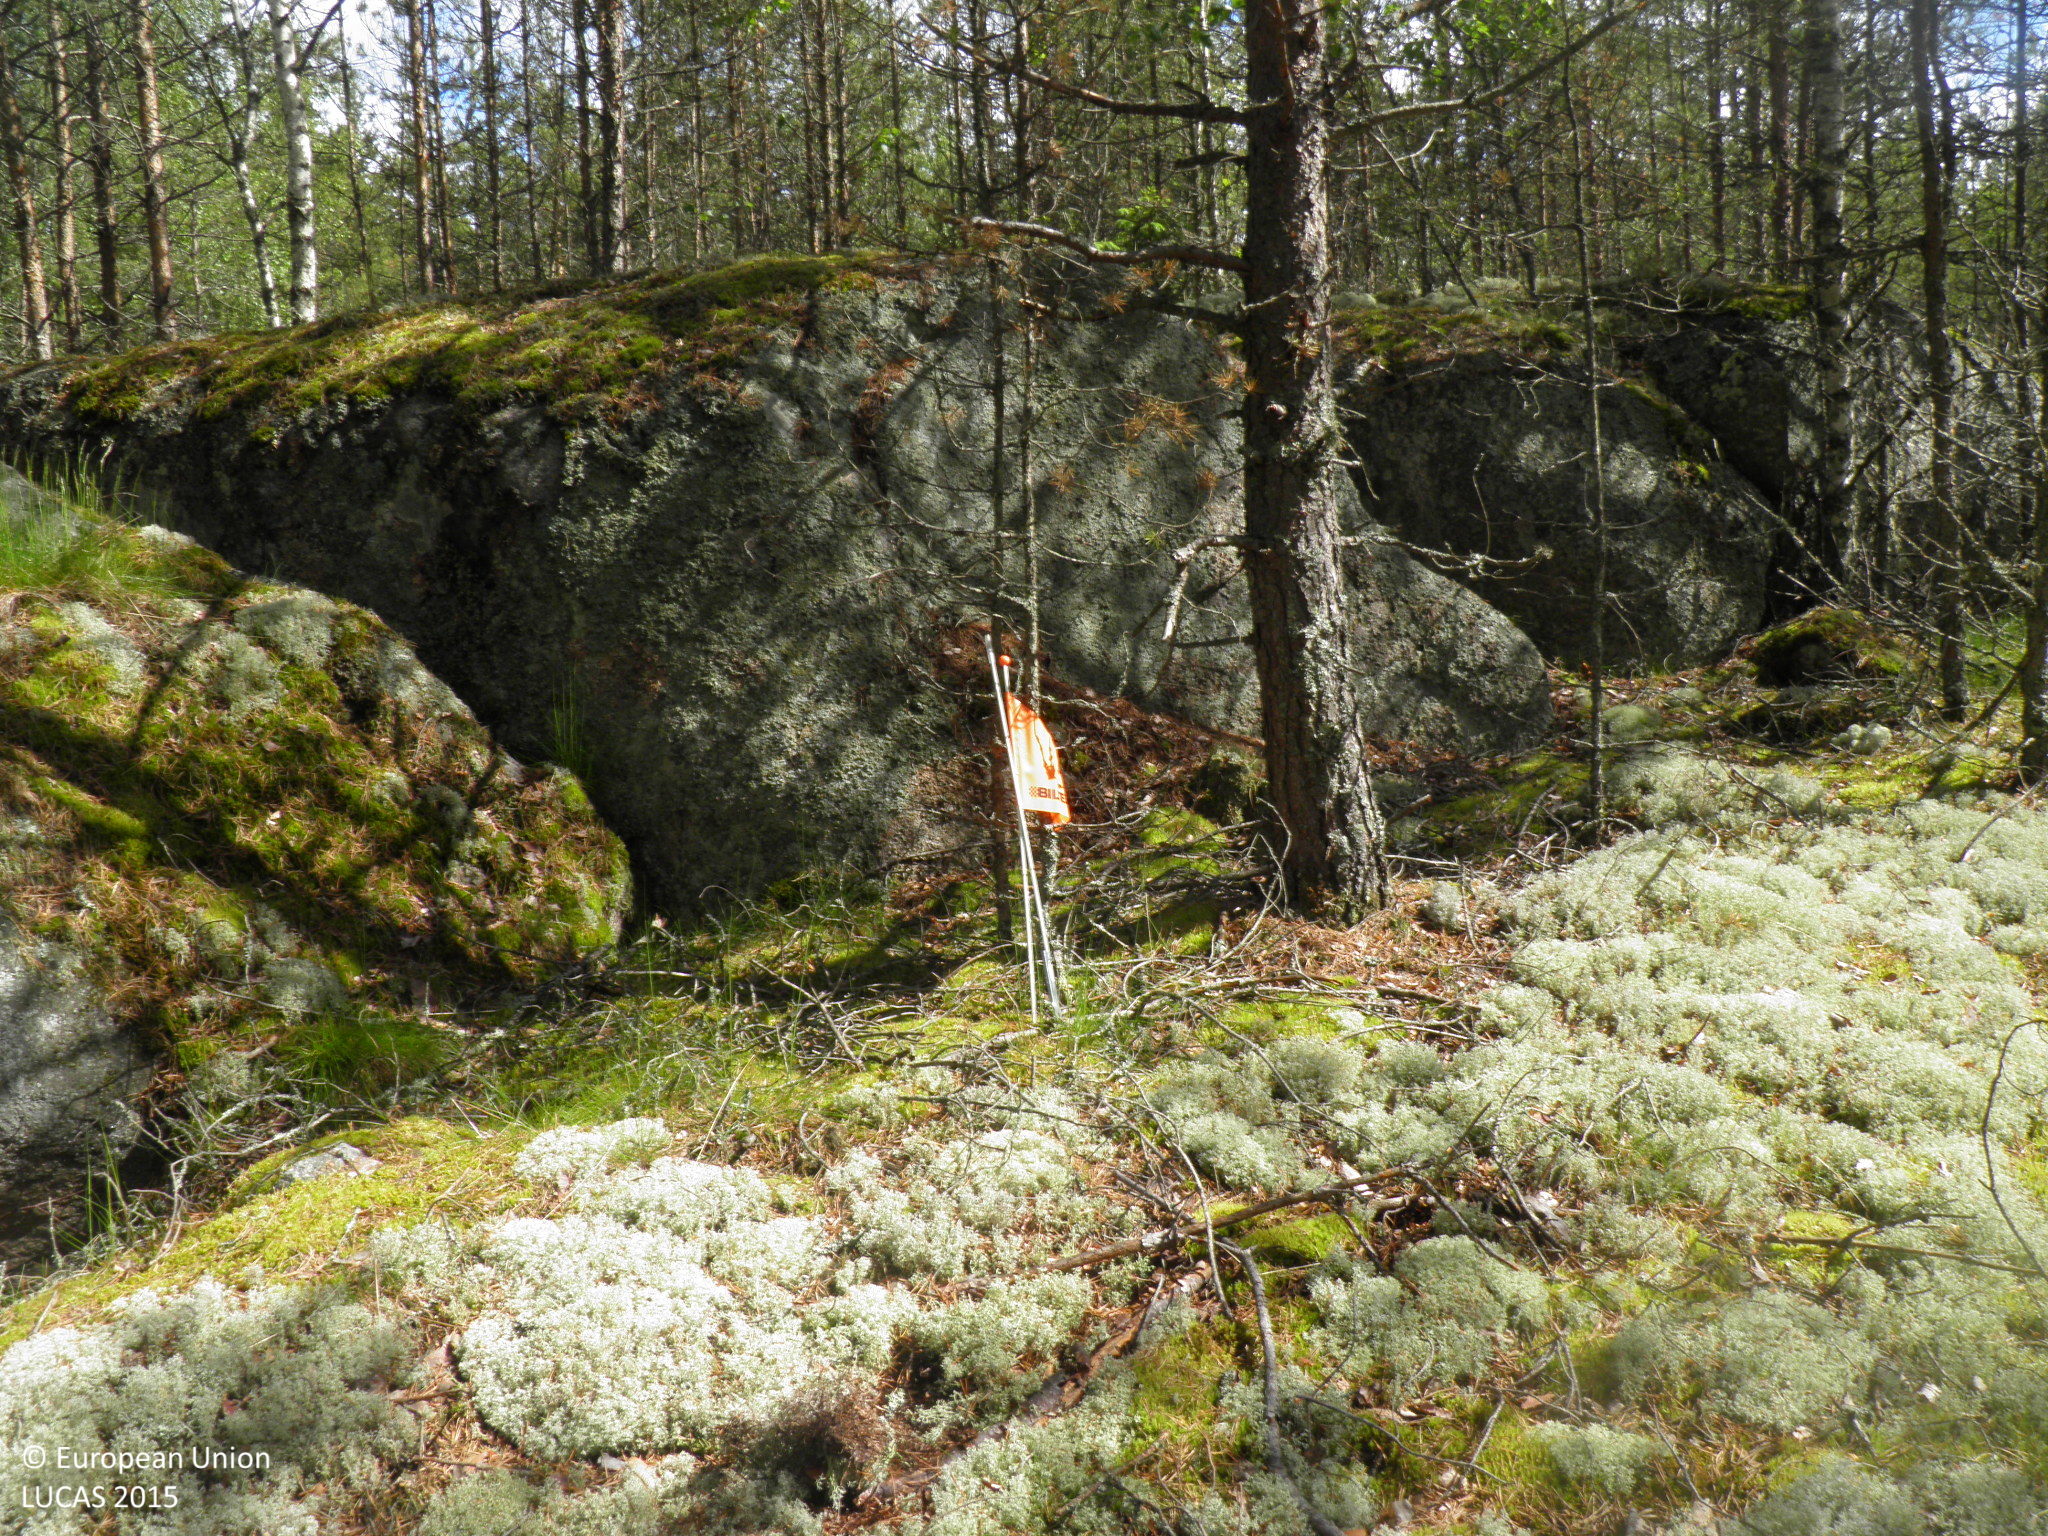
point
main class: Woodland
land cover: Pine dominated coniferous woodland
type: boreal forest
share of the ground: > 75 %
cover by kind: coniferous forest trees 80 %, lichens and mosses 10 %, shrubs 5 %, consolidated bare surface 5 %
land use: Forestry
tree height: > 5 m
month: June
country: FI
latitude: 60.5977
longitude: 21.9864
